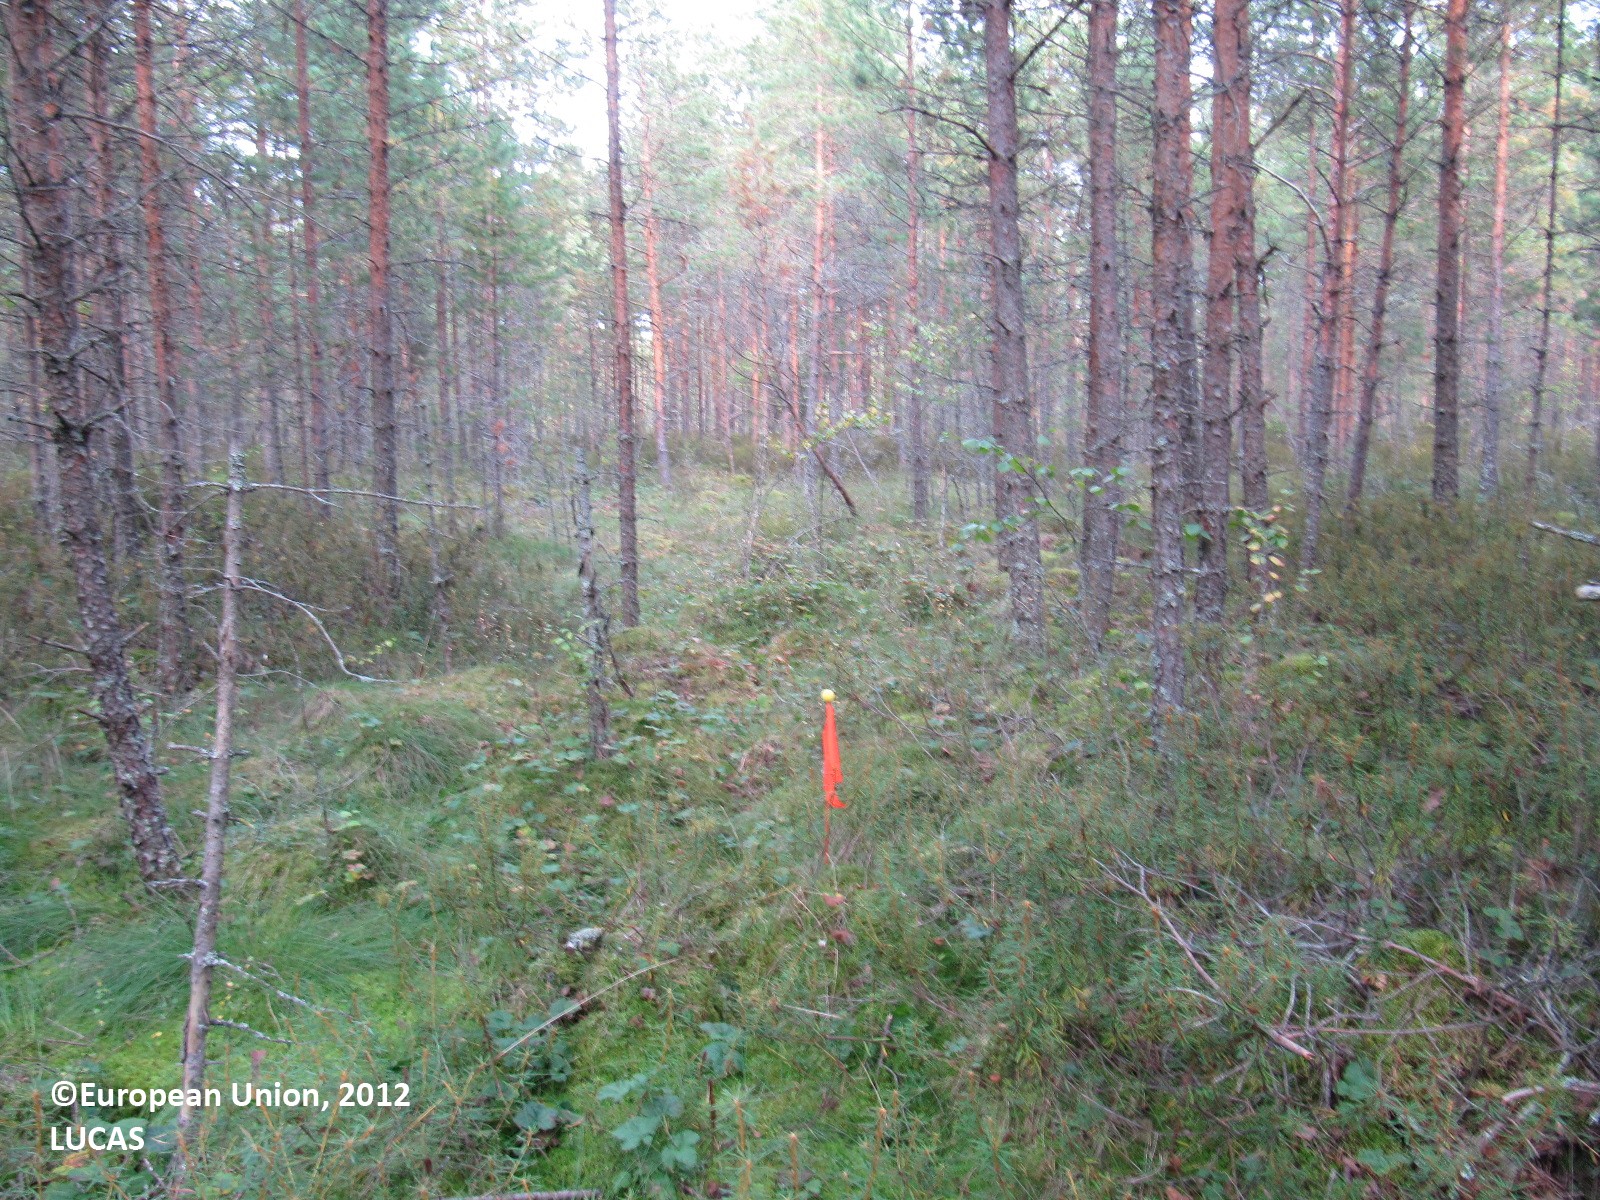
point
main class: Woodland
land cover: Pine dominated coniferous woodland
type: boreal forest
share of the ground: > 75 %
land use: Forestry
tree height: > 5 m
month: August
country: FI
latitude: 61.0617
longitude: 22.9495
